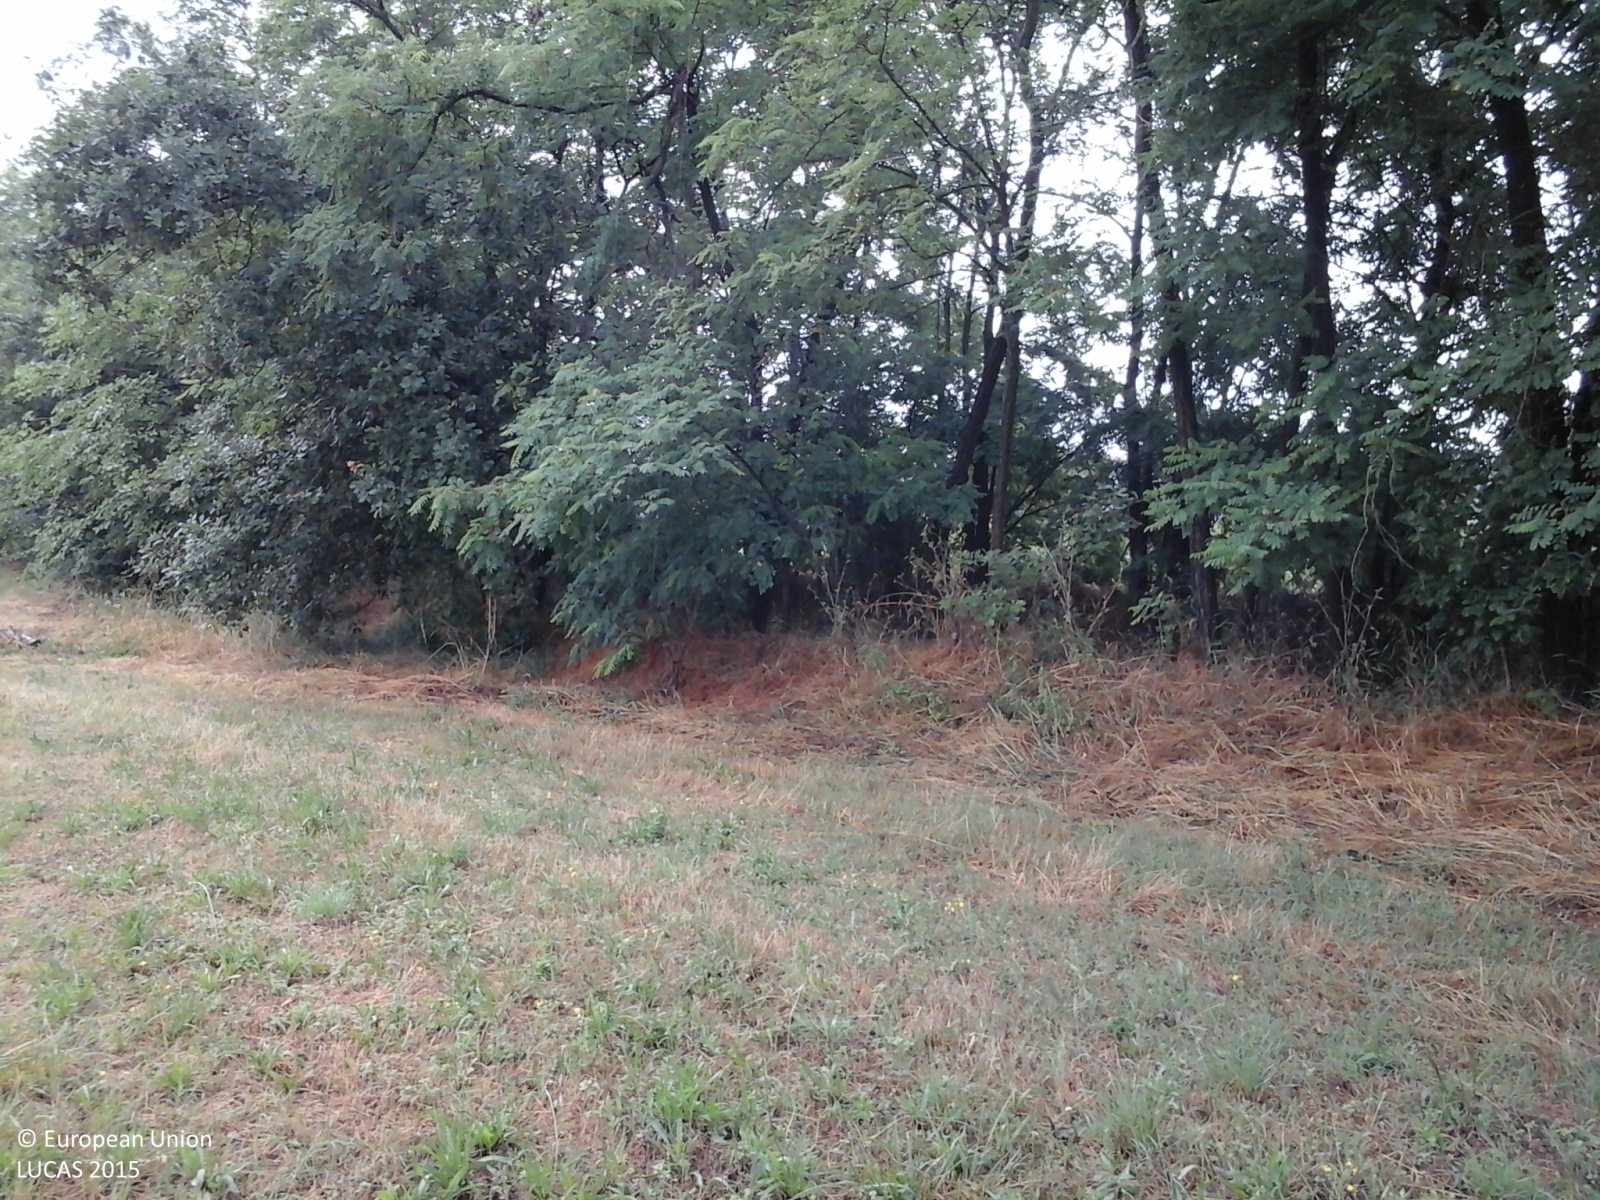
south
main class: Grassland
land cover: Spontaneously vegetated surfaces
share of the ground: > 75 %
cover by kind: herbaceous plants 100 %
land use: Agriculture (excluding fallow land and kitchen gardens)
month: June
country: IT
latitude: 44.7587
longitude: 8.8275
